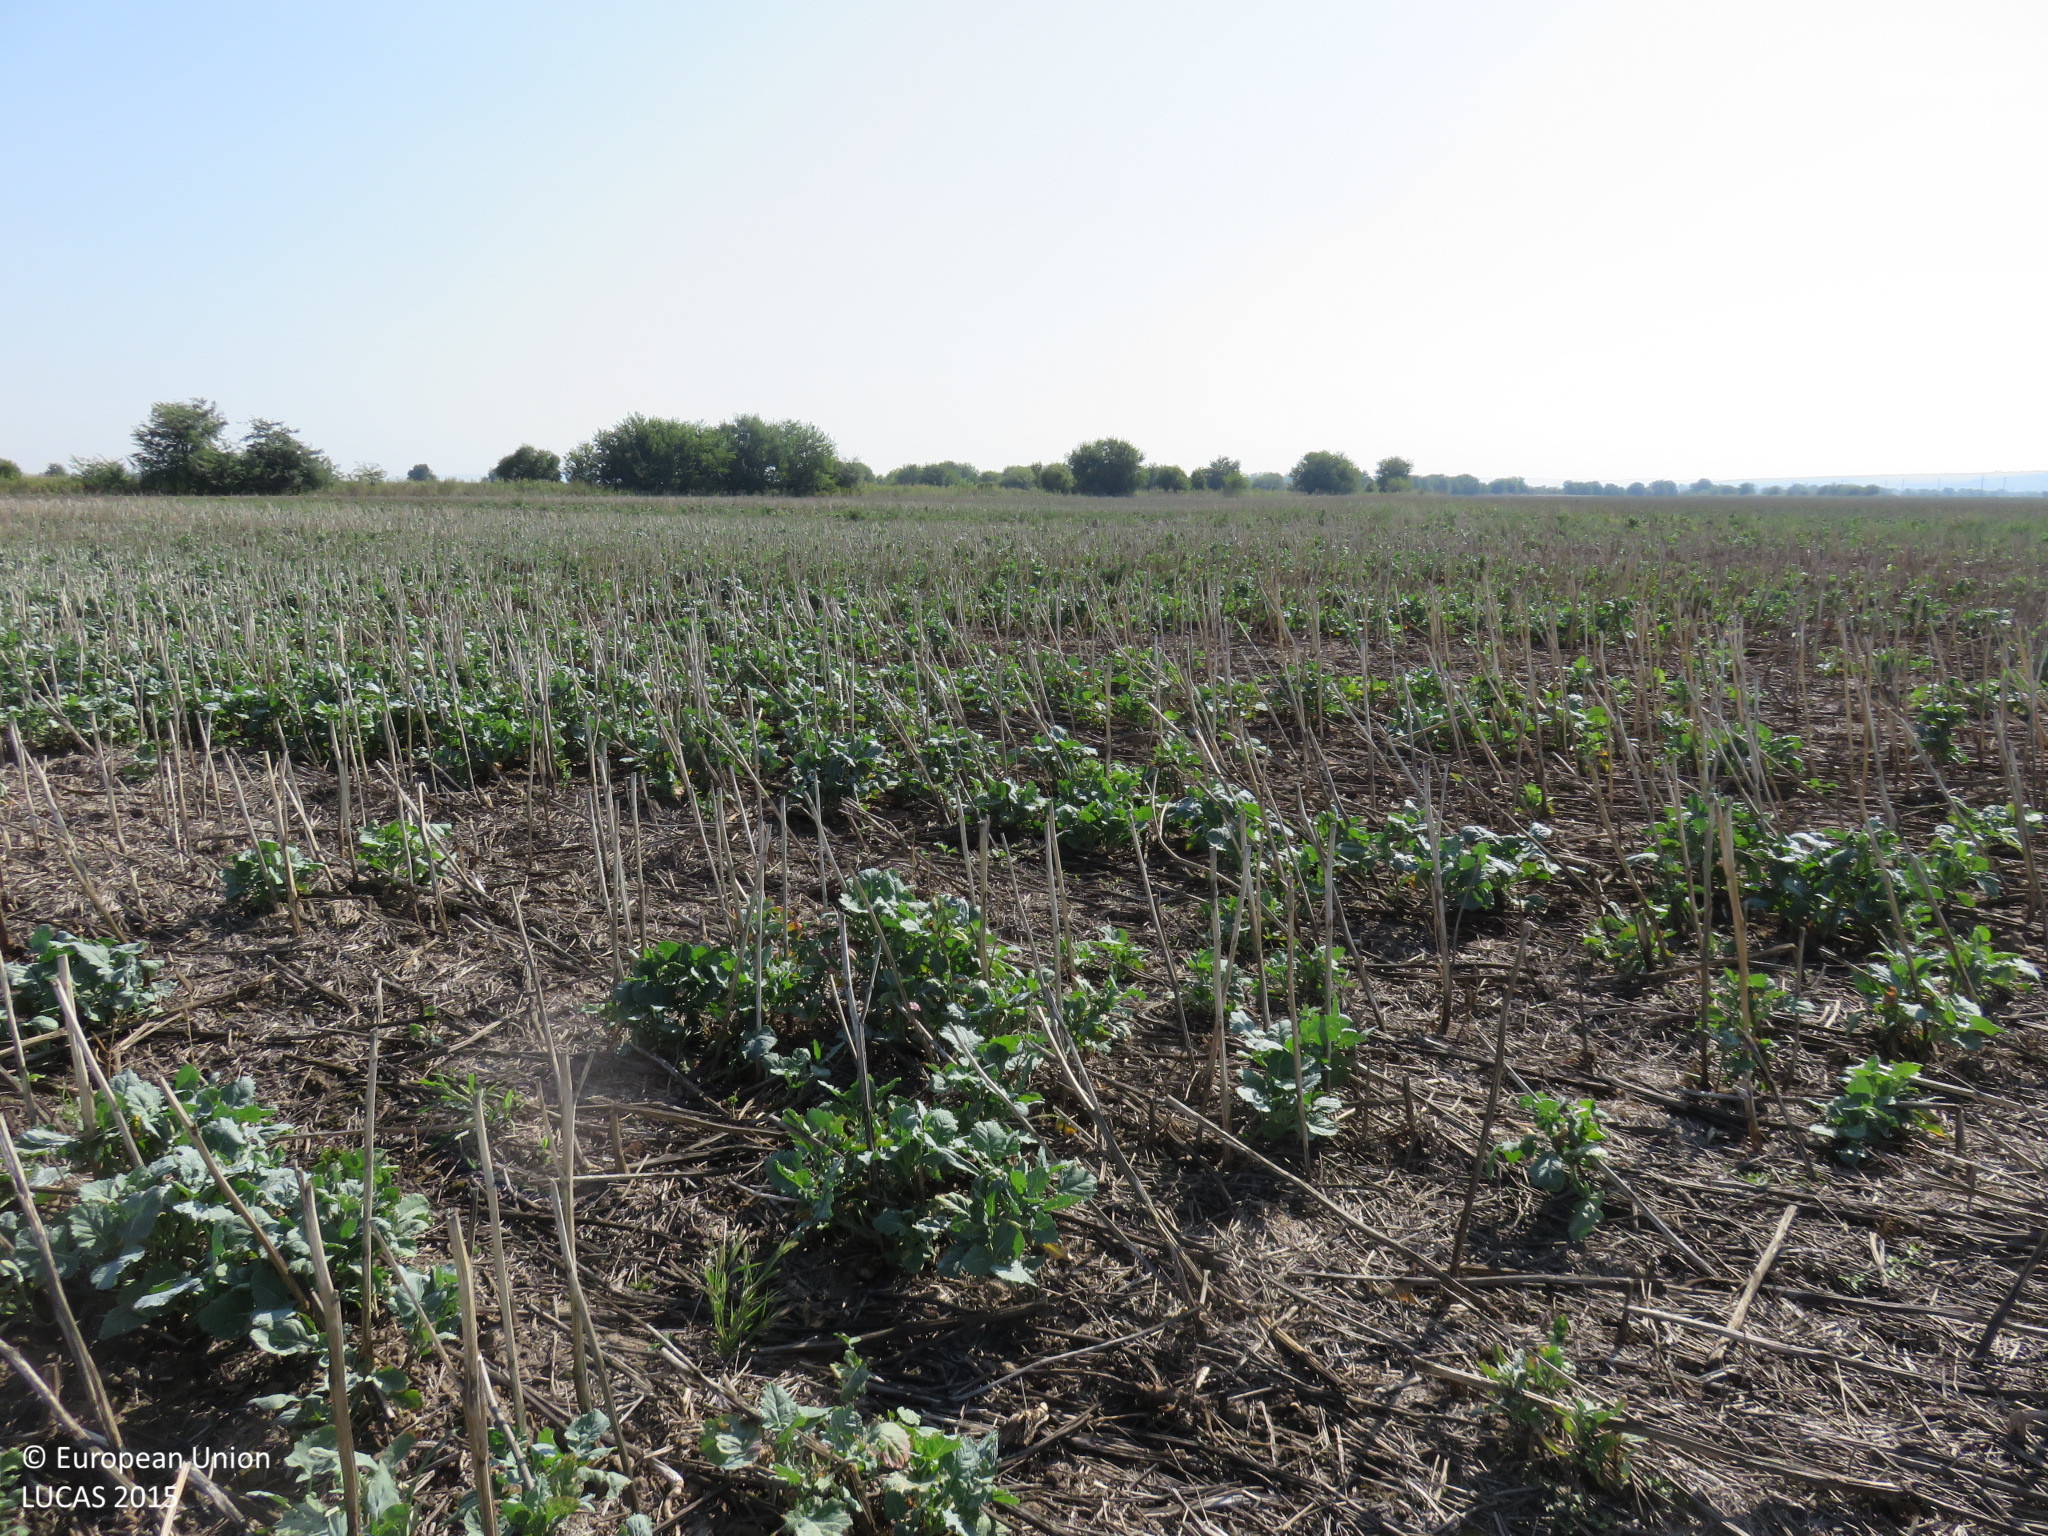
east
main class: Cropland
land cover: Rape and turnip rape
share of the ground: 50 - 75 %
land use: Agriculture (excluding fallow land and kitchen gardens)
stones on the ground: < 10 %
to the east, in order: Rape and turnip rape; Grassland with sparse tree/shrub cover; Ditches and canals; Grass margins; Maize
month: September
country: BG
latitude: 43.6647
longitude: 24.5615
